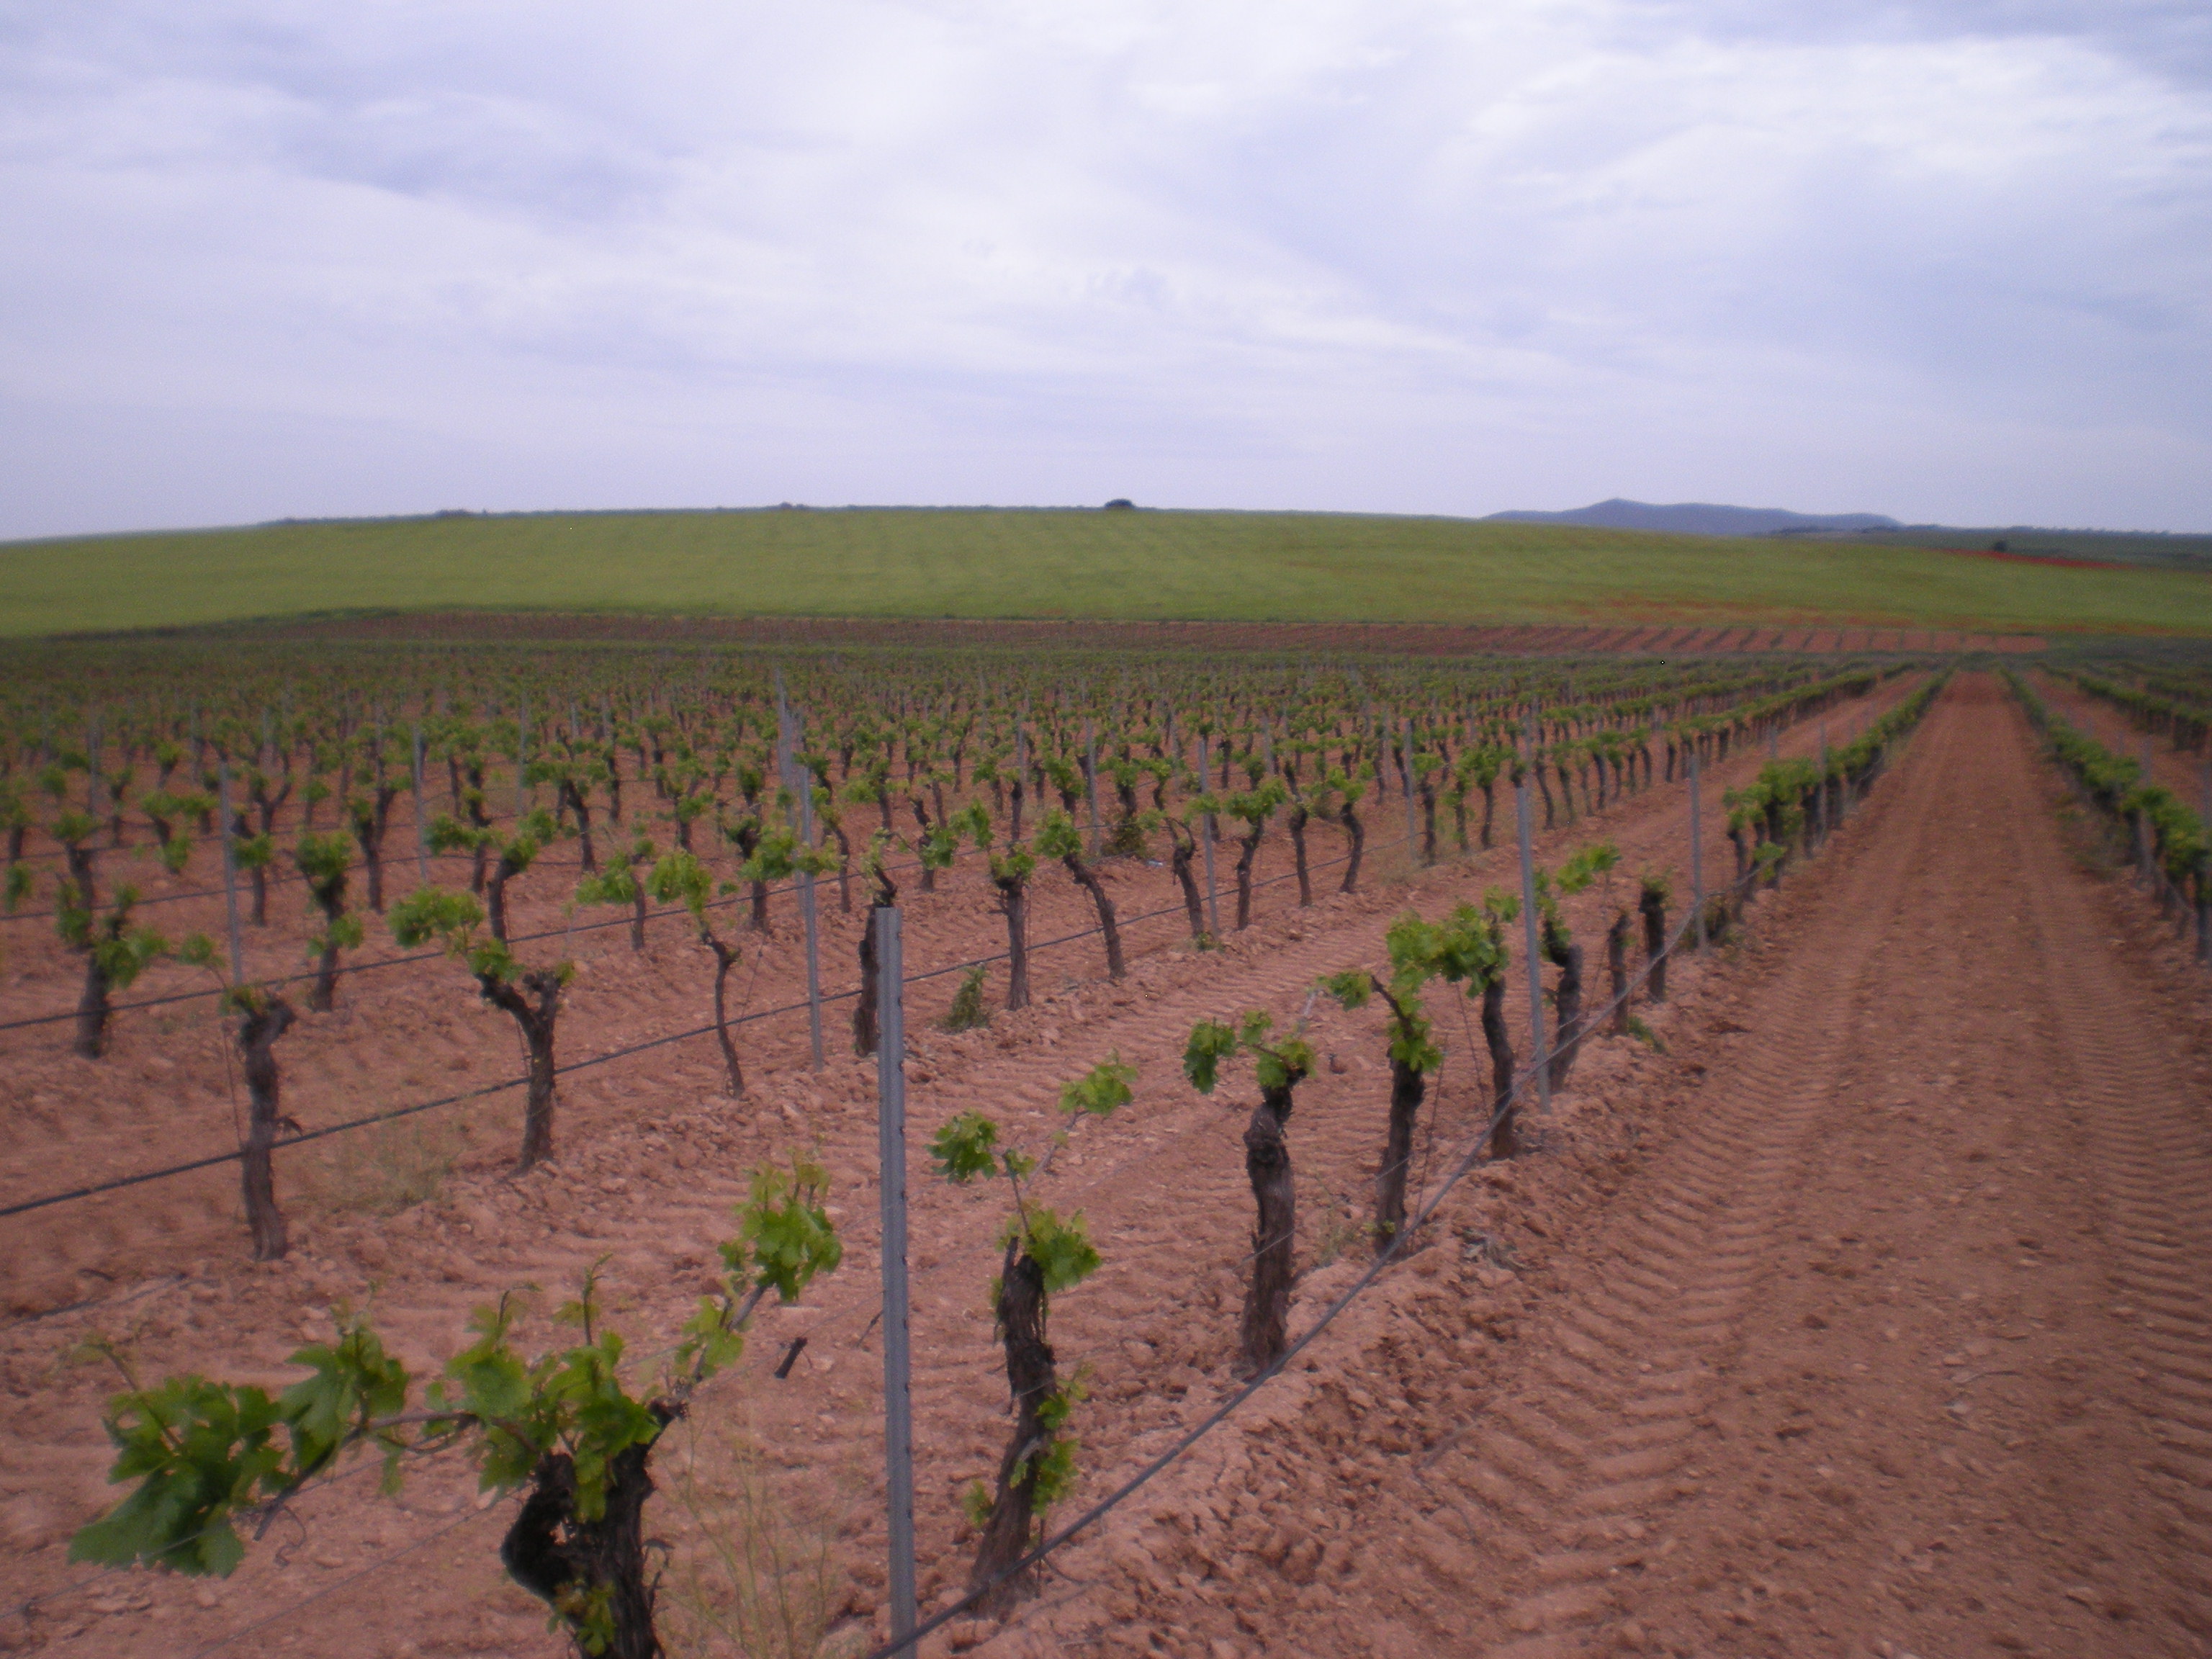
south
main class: Cropland
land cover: Vineyards
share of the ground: < 10 %
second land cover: Other bare soil
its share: > 75 %
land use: Agriculture (excluding fallow land and kitchen gardens)
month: May
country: ES
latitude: 38.7329
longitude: -3.1800
